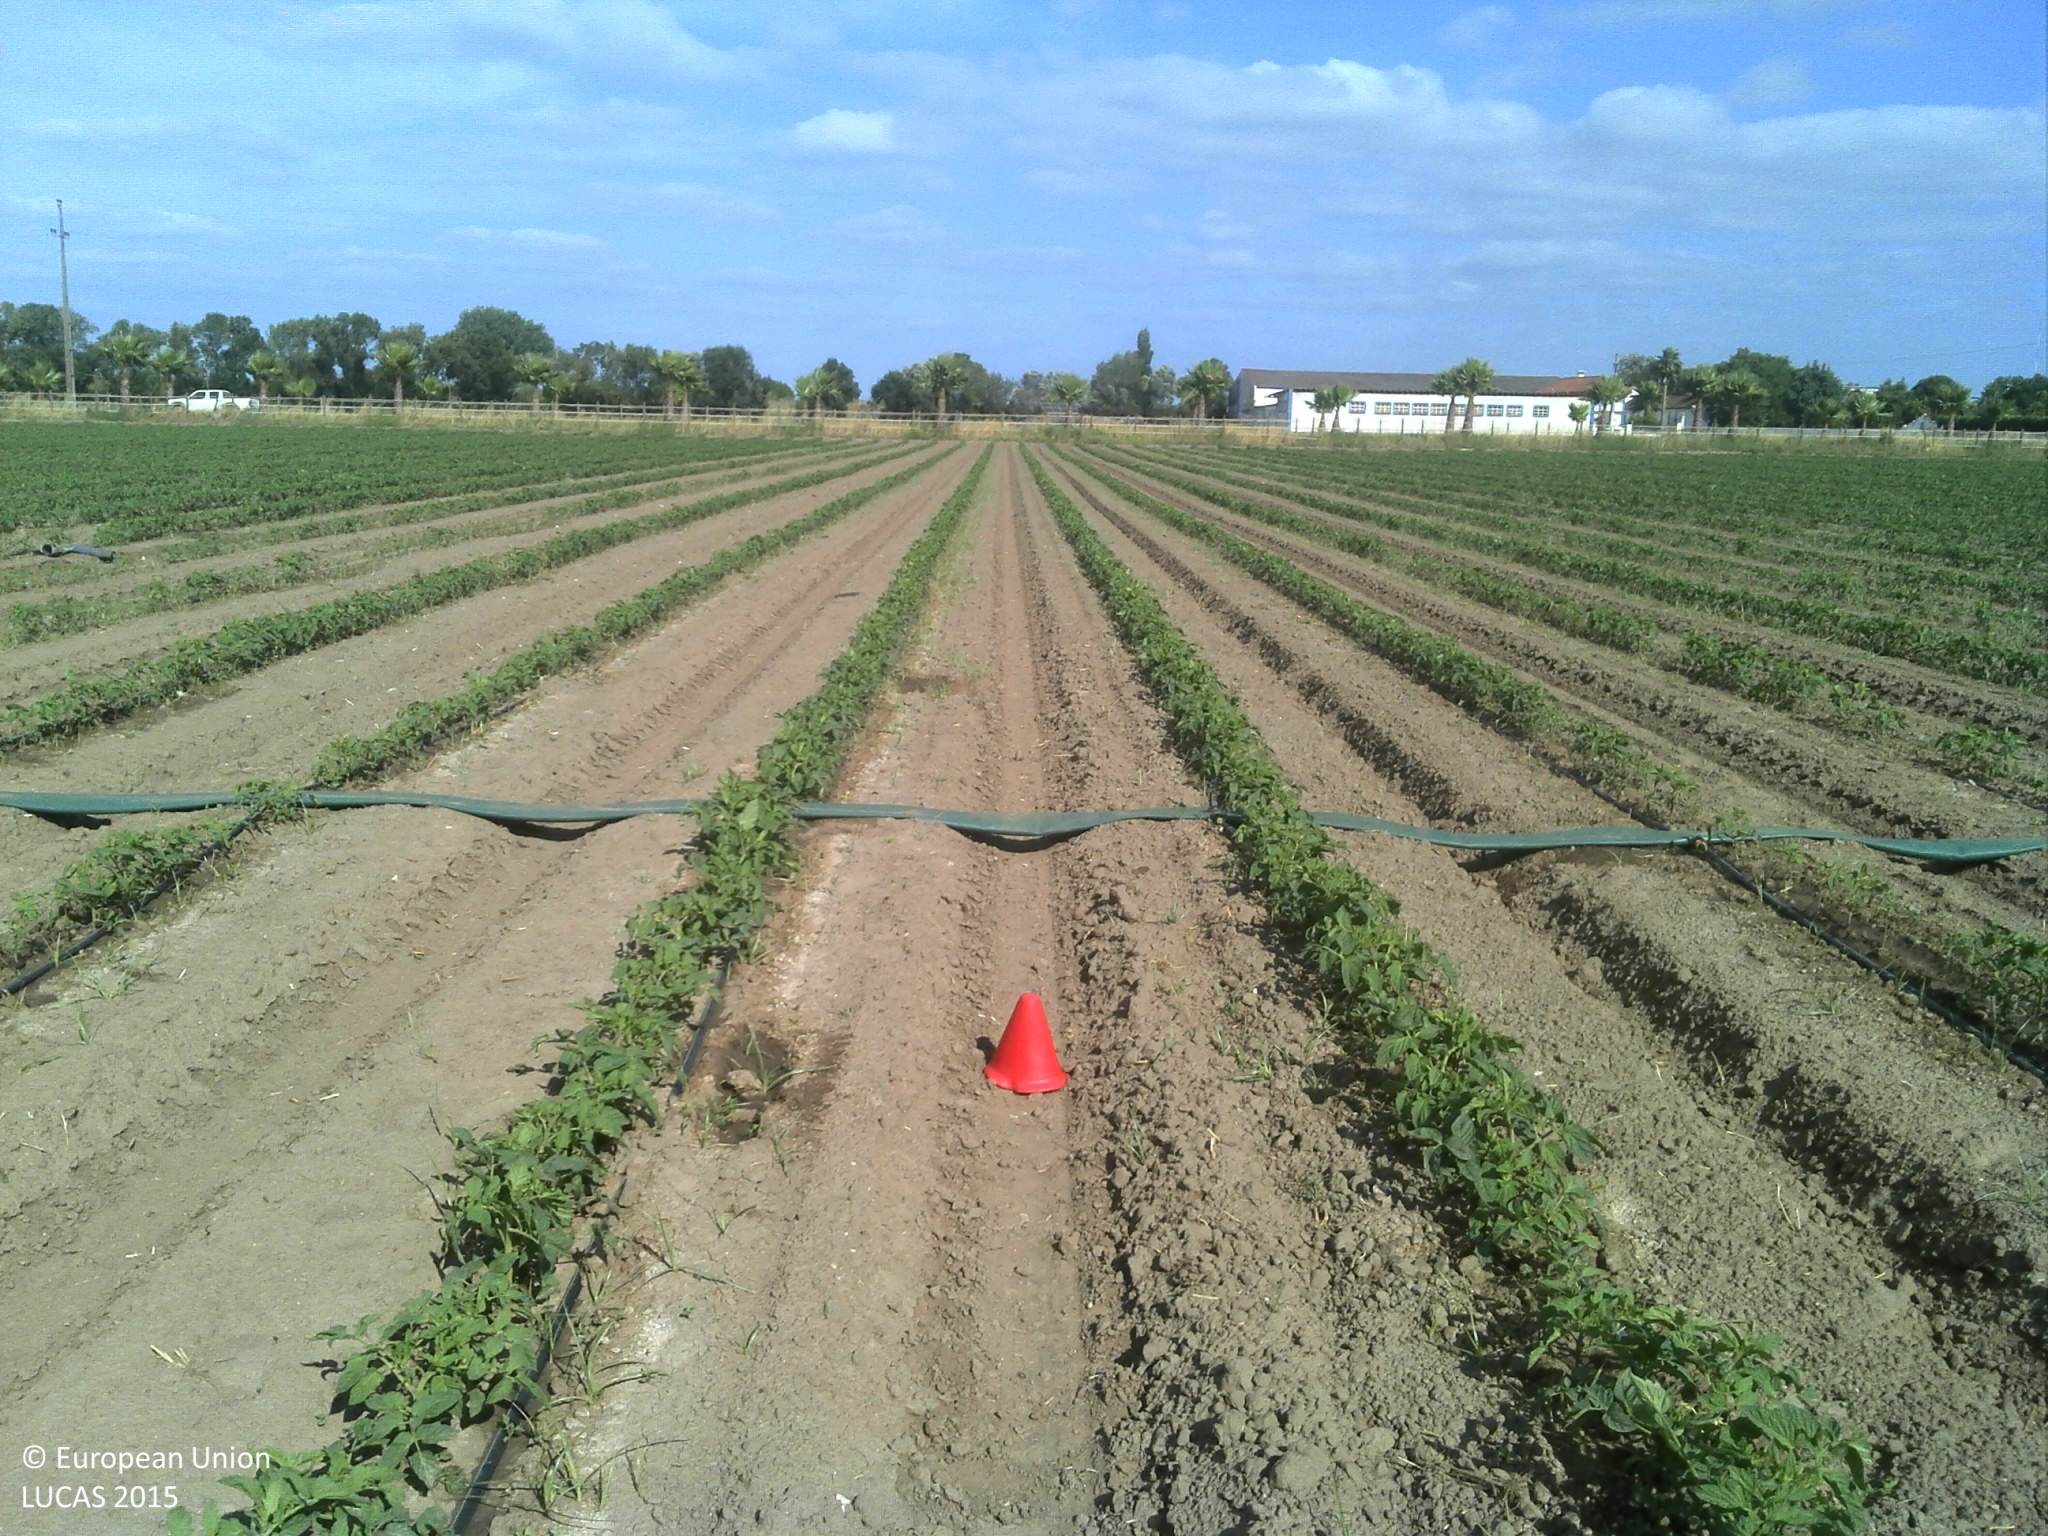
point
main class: Cropland
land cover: Tomatoes
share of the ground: 10 - 25 %
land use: Agriculture (excluding fallow land and kitchen gardens)
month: June
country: PT
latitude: 39.1301
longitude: -8.7308
